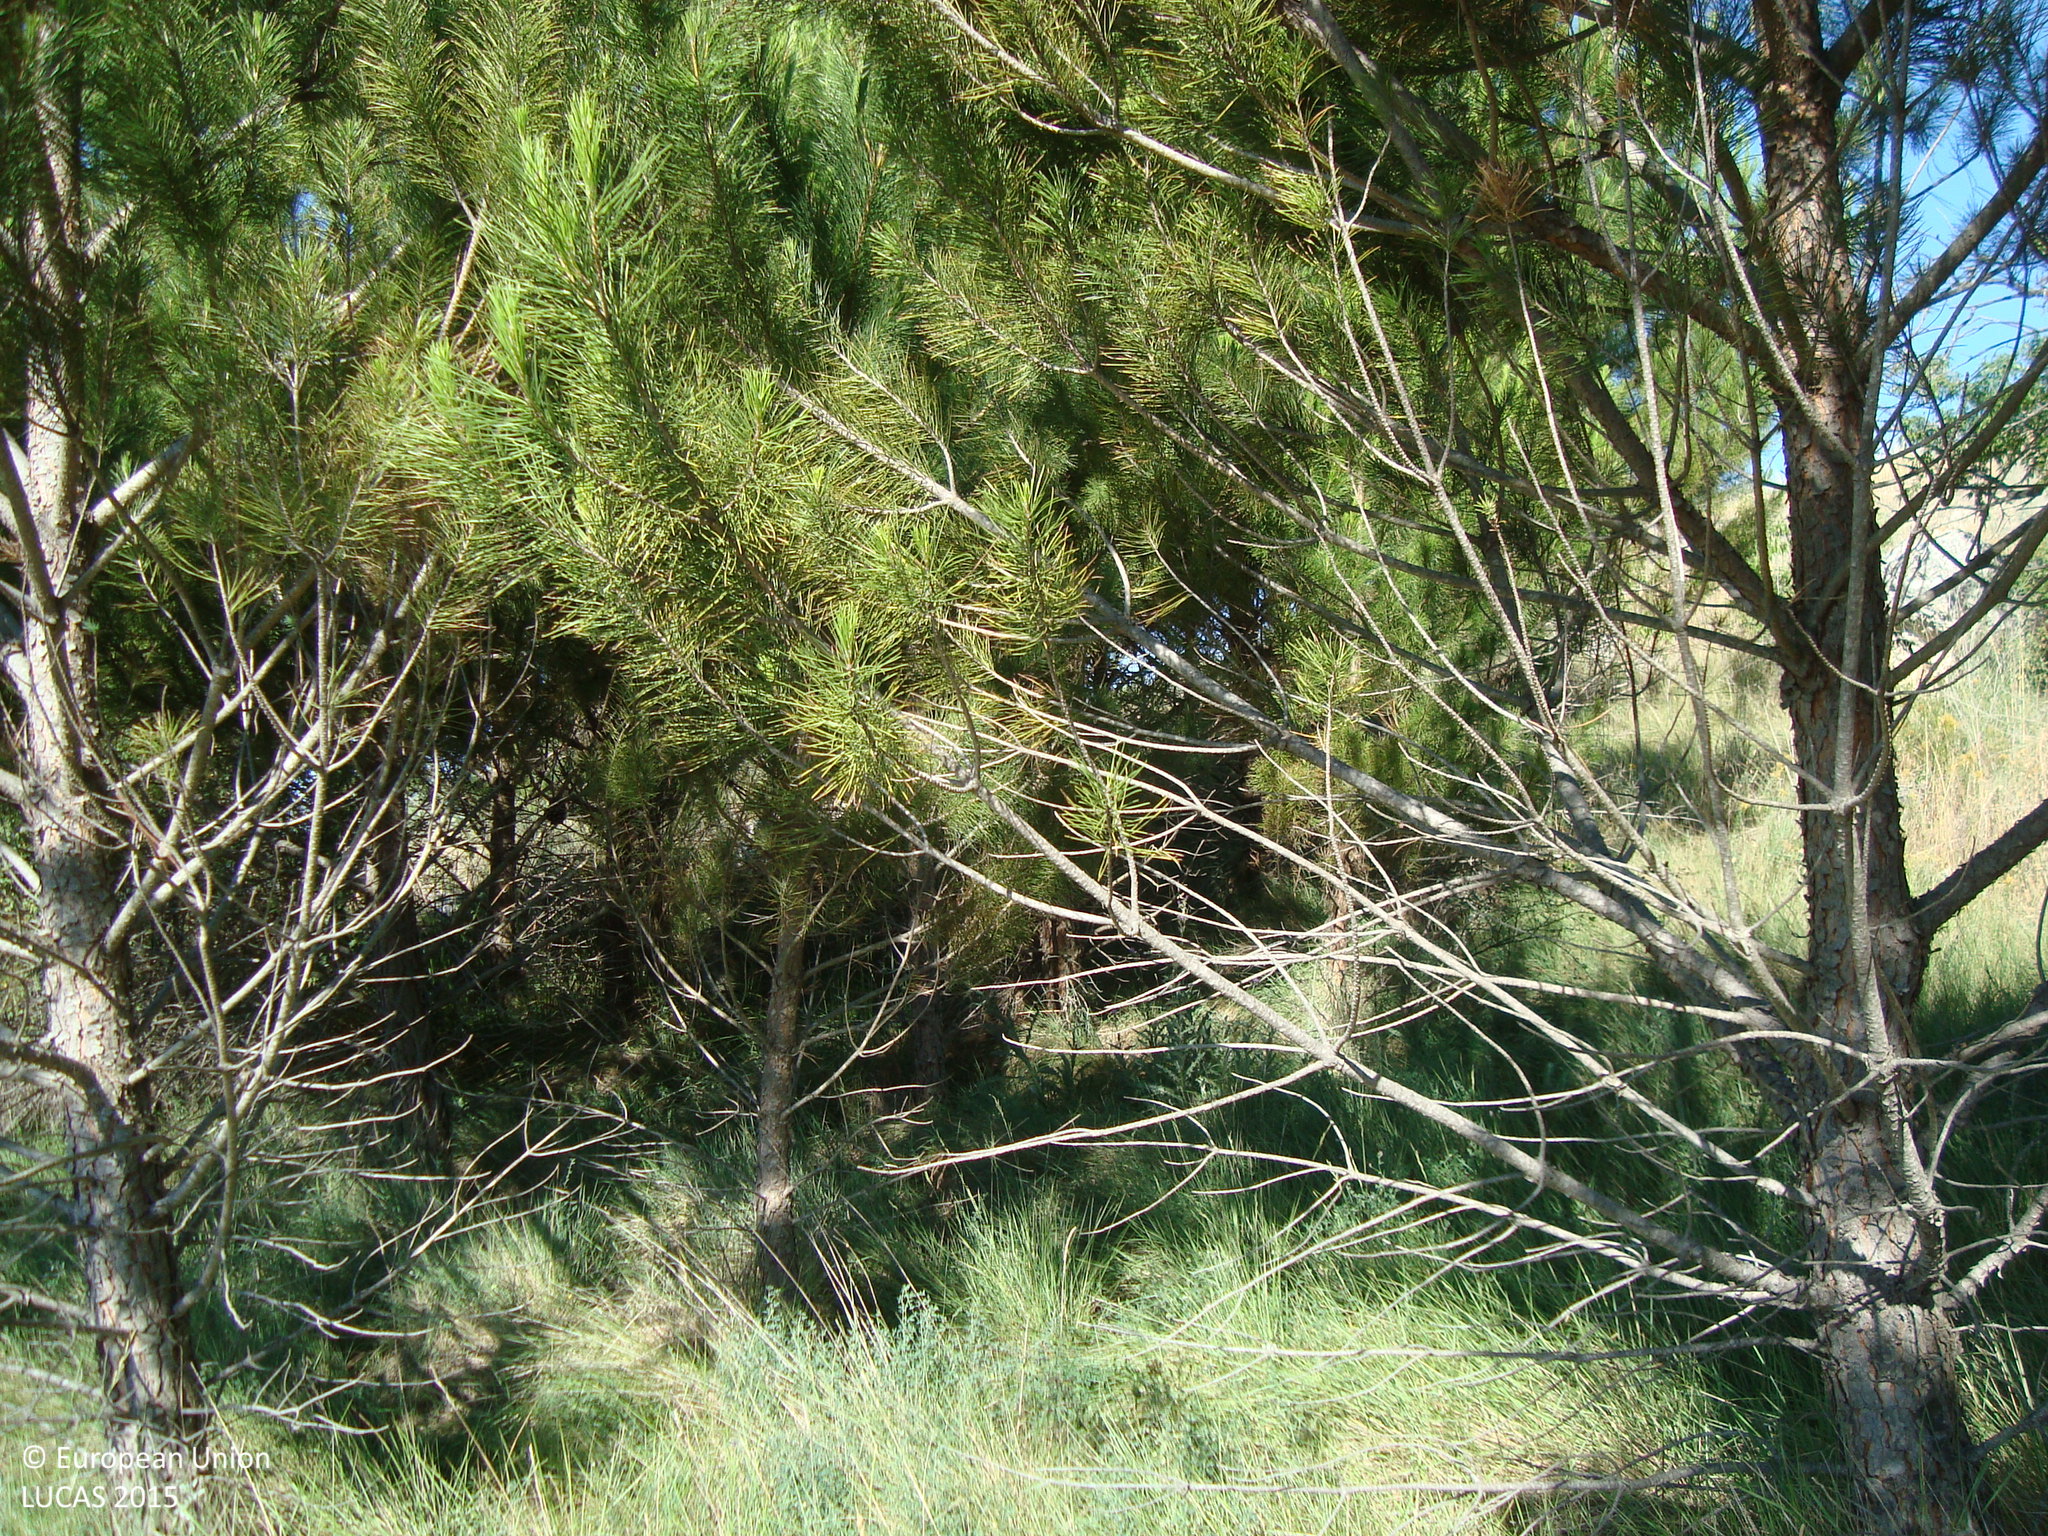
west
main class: Woodland
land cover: Pine dominated coniferous woodland
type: coniferous forest of the mediterranean region
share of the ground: 50 - 75 %
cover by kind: coniferous forest trees 60 %, shrubs 20 %, herbaceous plants 10 %, unconsolidated bare surface 10 %
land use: Forestry
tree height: > 5 m
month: July
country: ES
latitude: 41.6303
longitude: -4.0661
